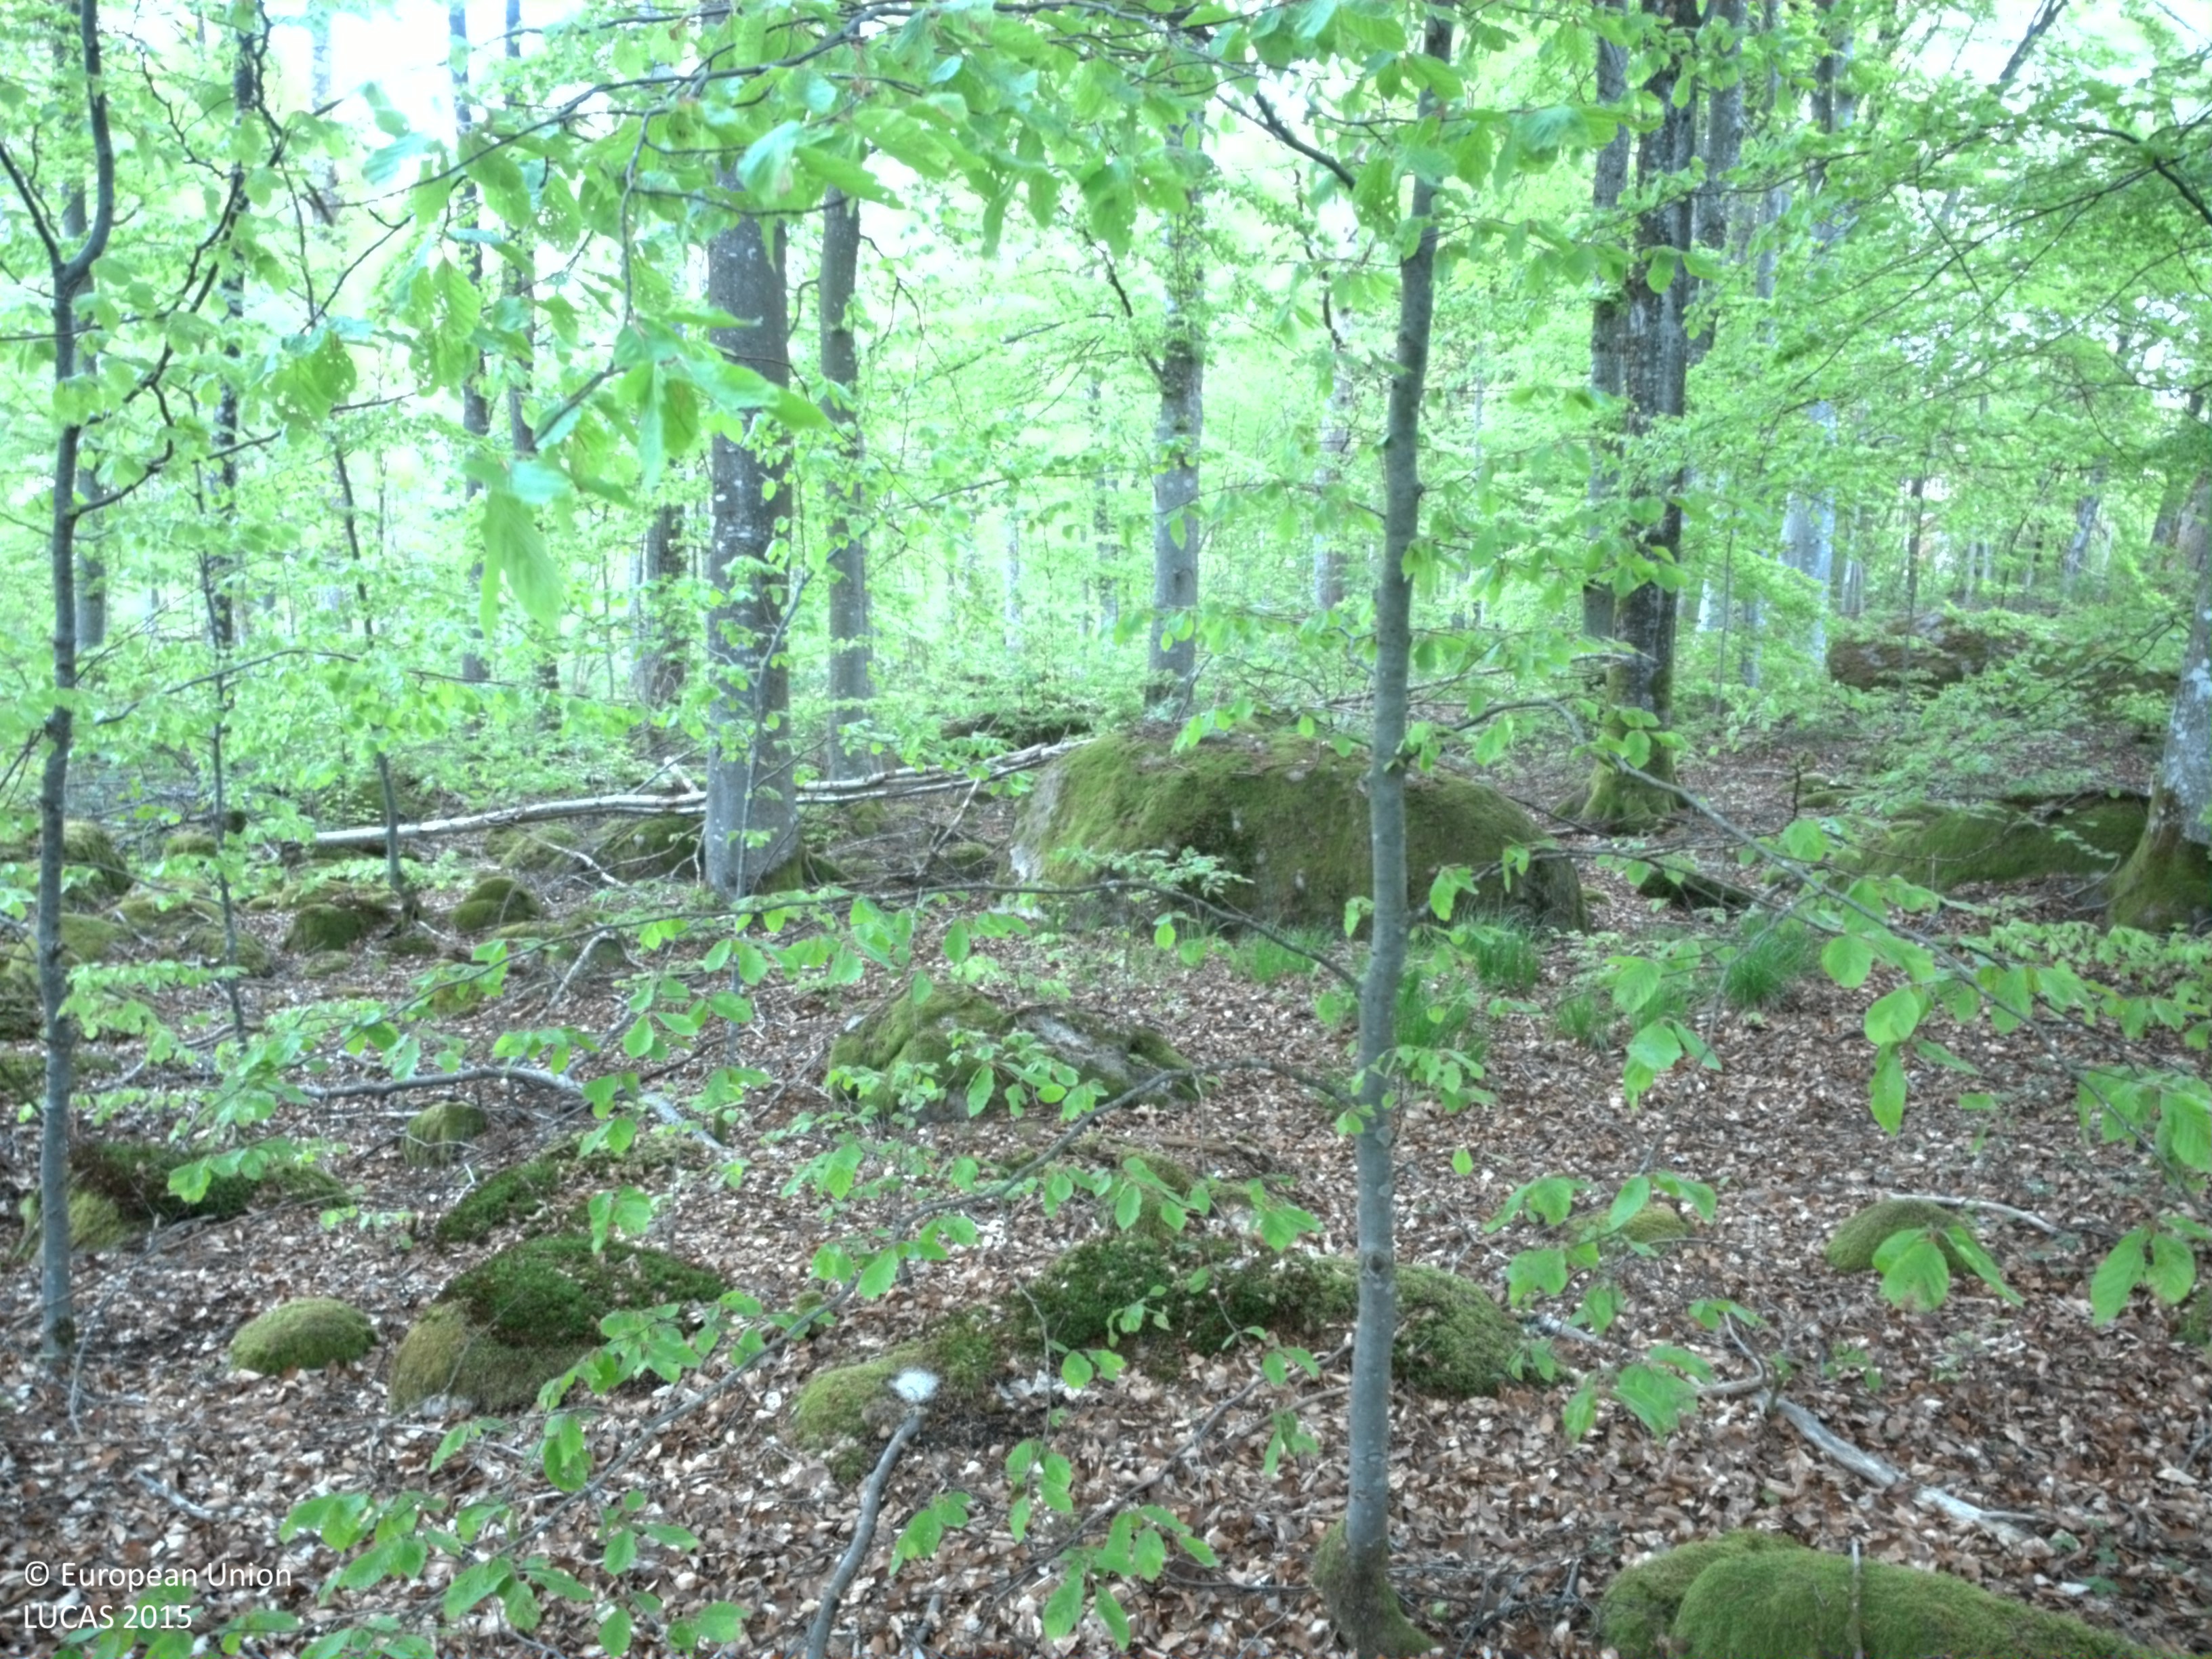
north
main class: Woodland
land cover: Broadleaved woodland
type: beech forest
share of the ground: > 75 %
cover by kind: broadleaved forest trees 80 %, herbaceous plants 10 %, lichens and mosses 10 %
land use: Amenities, museums, leisure
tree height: > 5 m
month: May
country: SE
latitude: 56.6487
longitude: 14.5149
